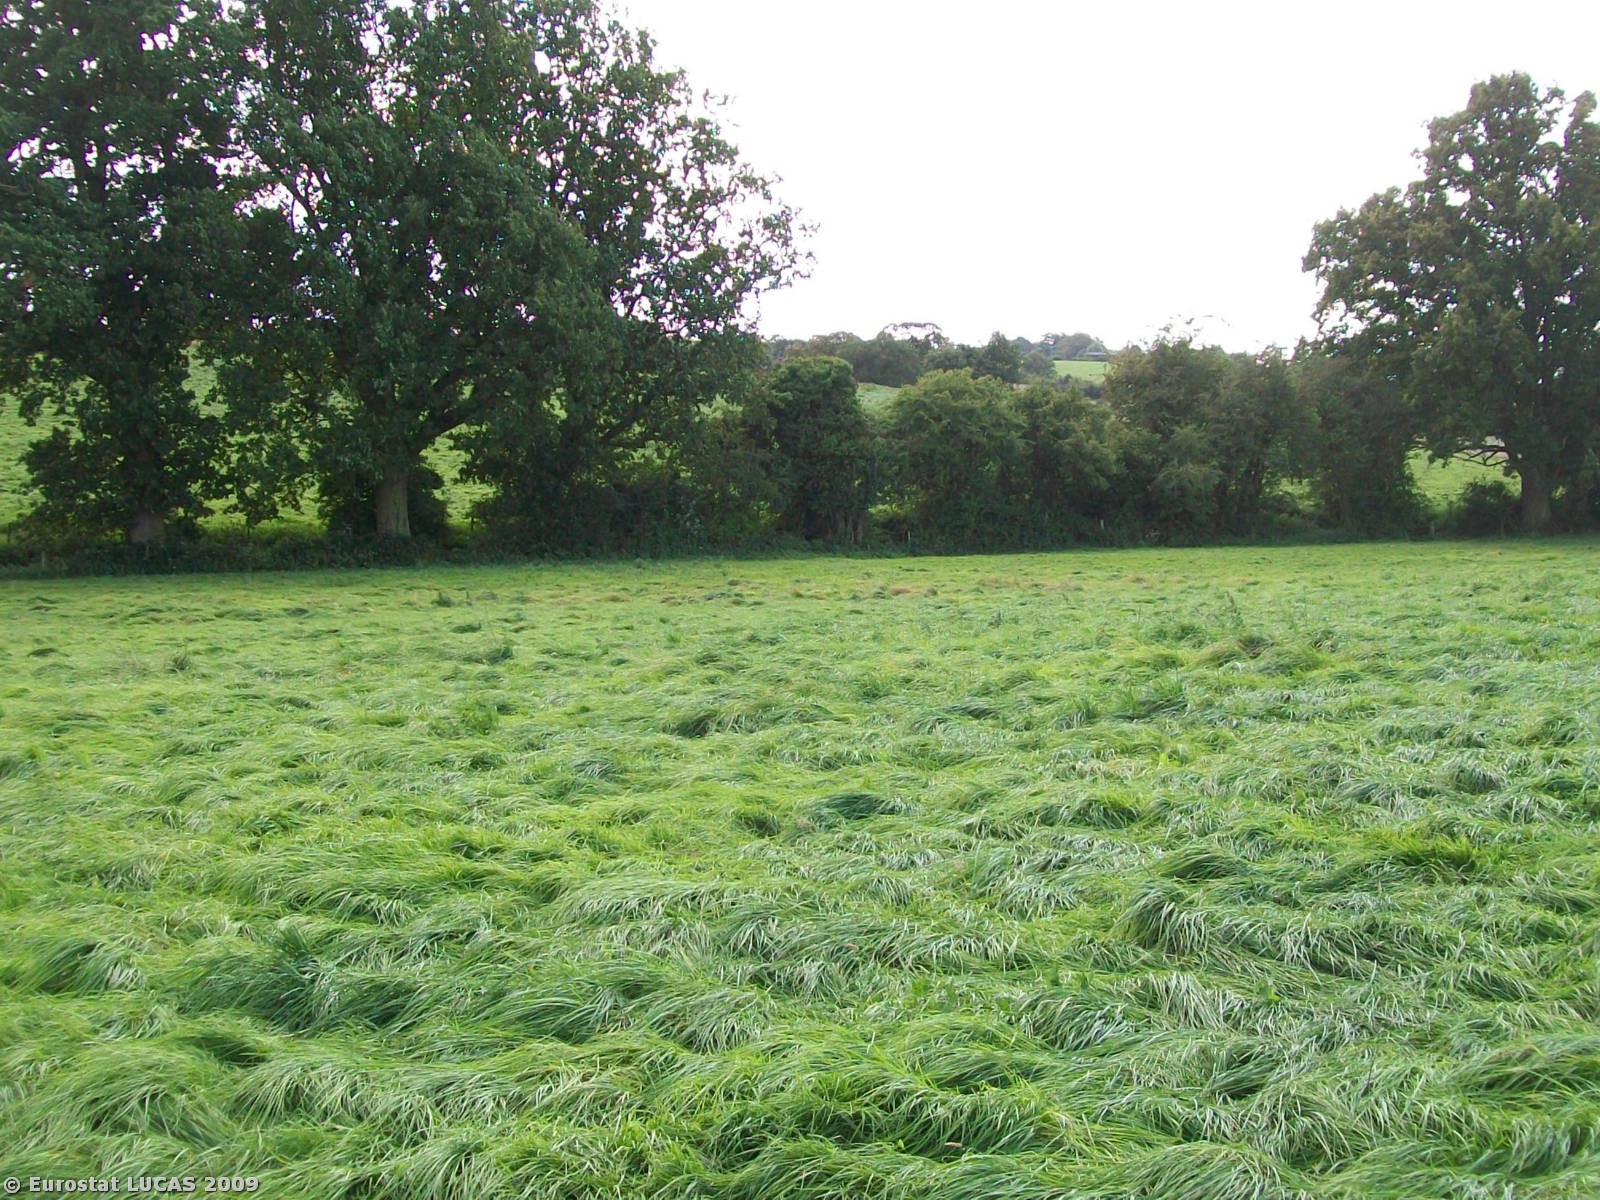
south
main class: Grassland
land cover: Grassland without tree/shrub cover
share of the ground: > 75 %
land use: Agriculture (excluding fallow land and kitchen gardens)
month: August
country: GB
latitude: 51.9854
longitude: -2.3388
